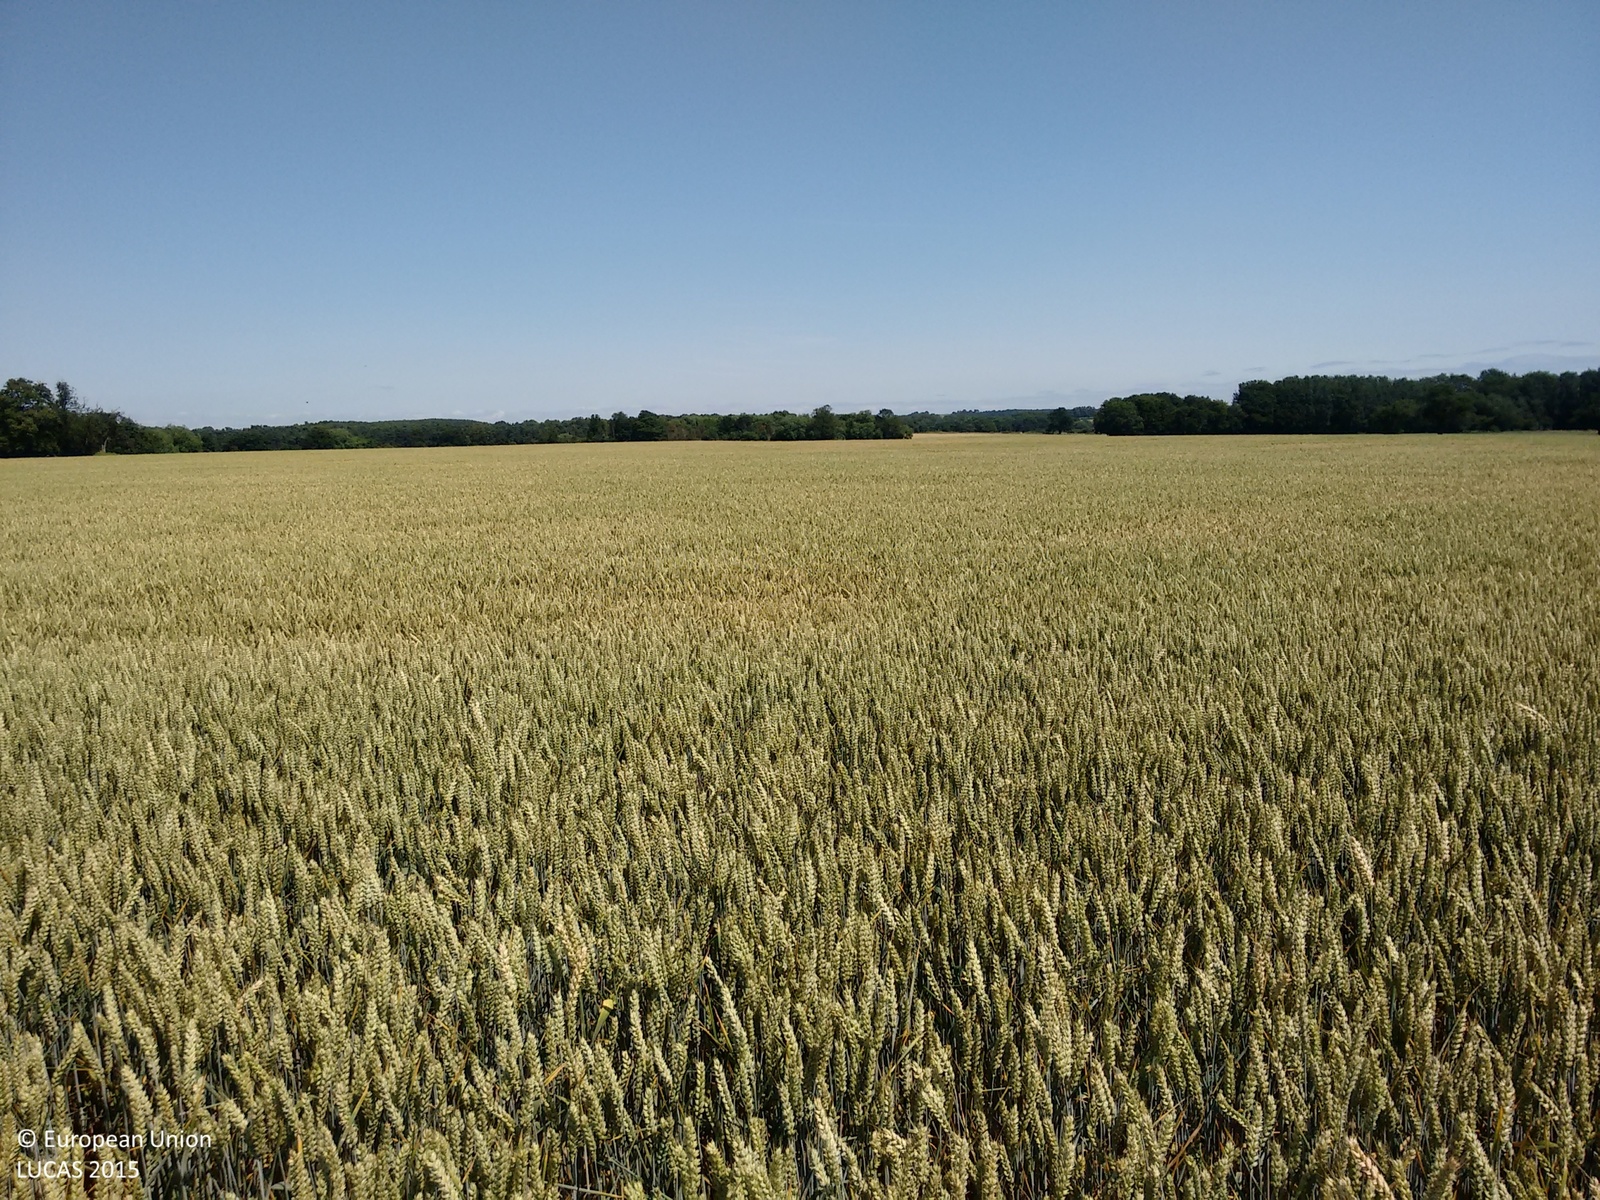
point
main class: Cropland
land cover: Common wheat
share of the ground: > 75 %
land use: Agriculture (excluding fallow land and kitchen gardens)
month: July
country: GB
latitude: 53.2469
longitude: -0.9682
